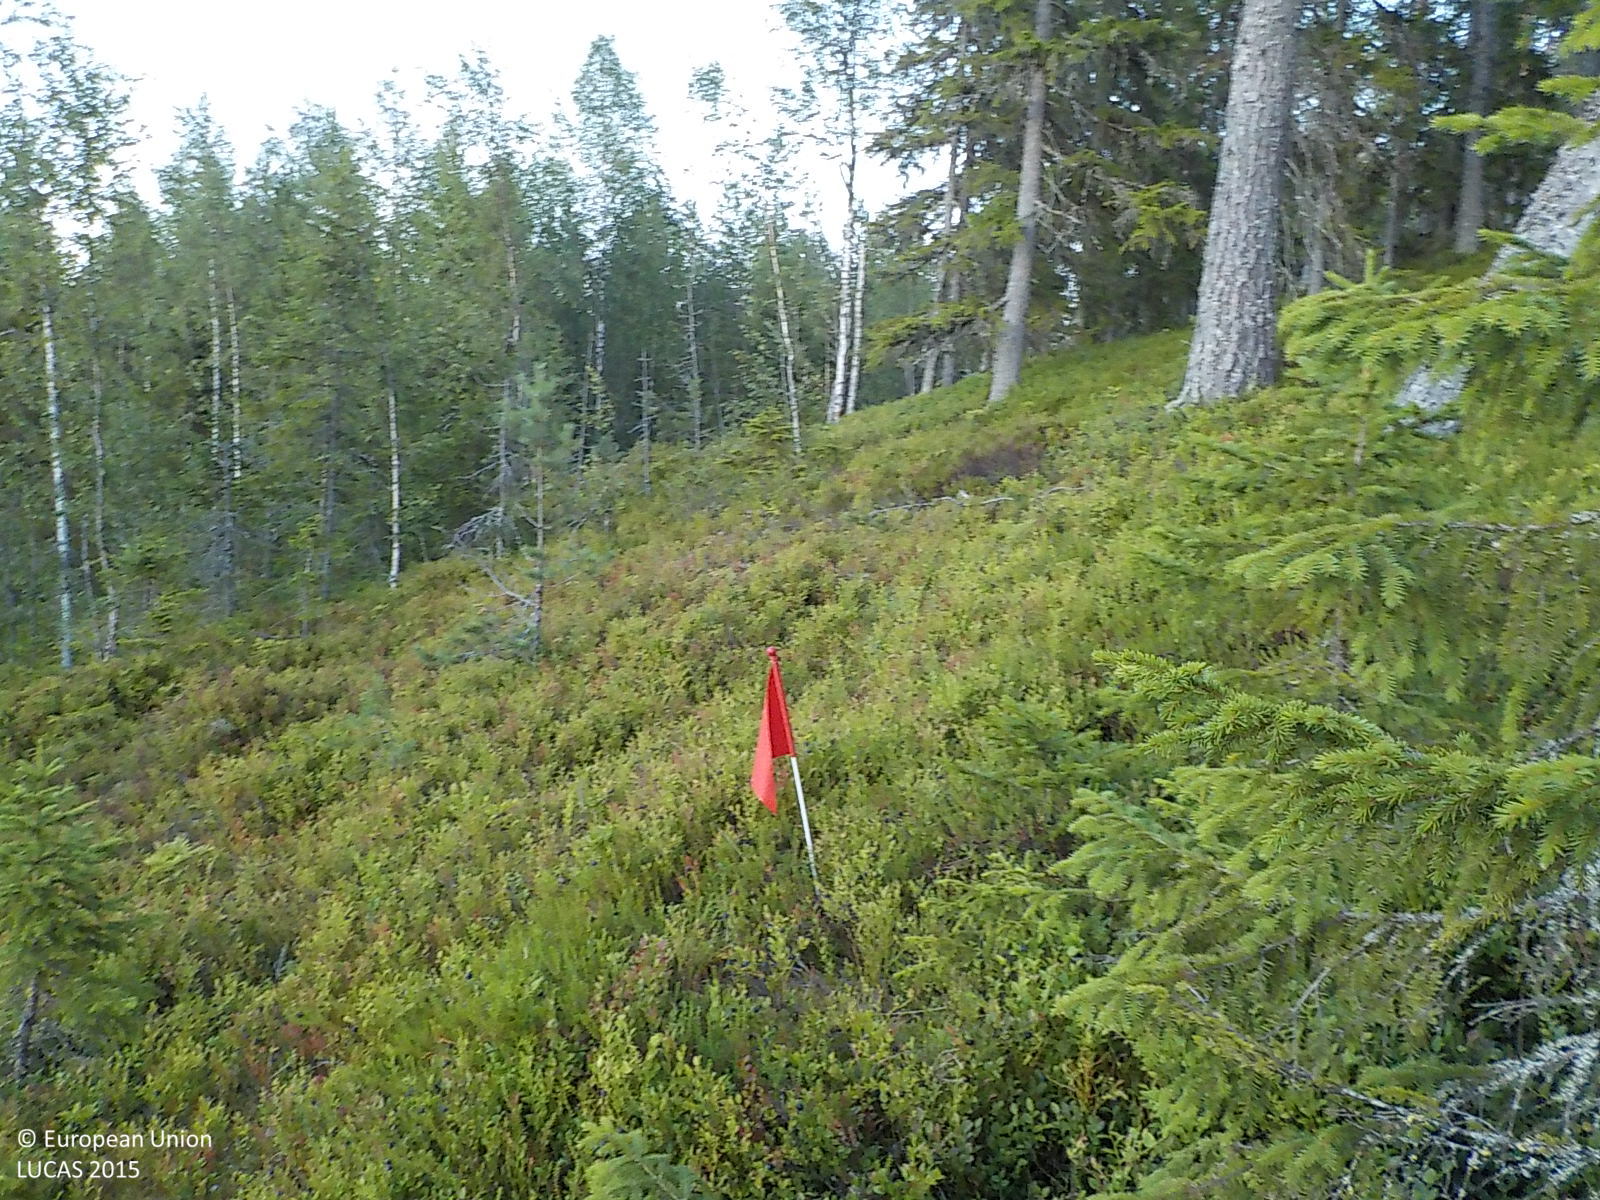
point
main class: Woodland
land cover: Pine dominated mixed woodland
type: boreal forest
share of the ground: 10 - 25 %
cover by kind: shrubs 80 %, coniferous forest trees 15 %, broadleaved forest trees 5 %
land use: Forestry
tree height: > 5 m
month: August
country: SE
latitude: 63.4792
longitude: 18.8296
